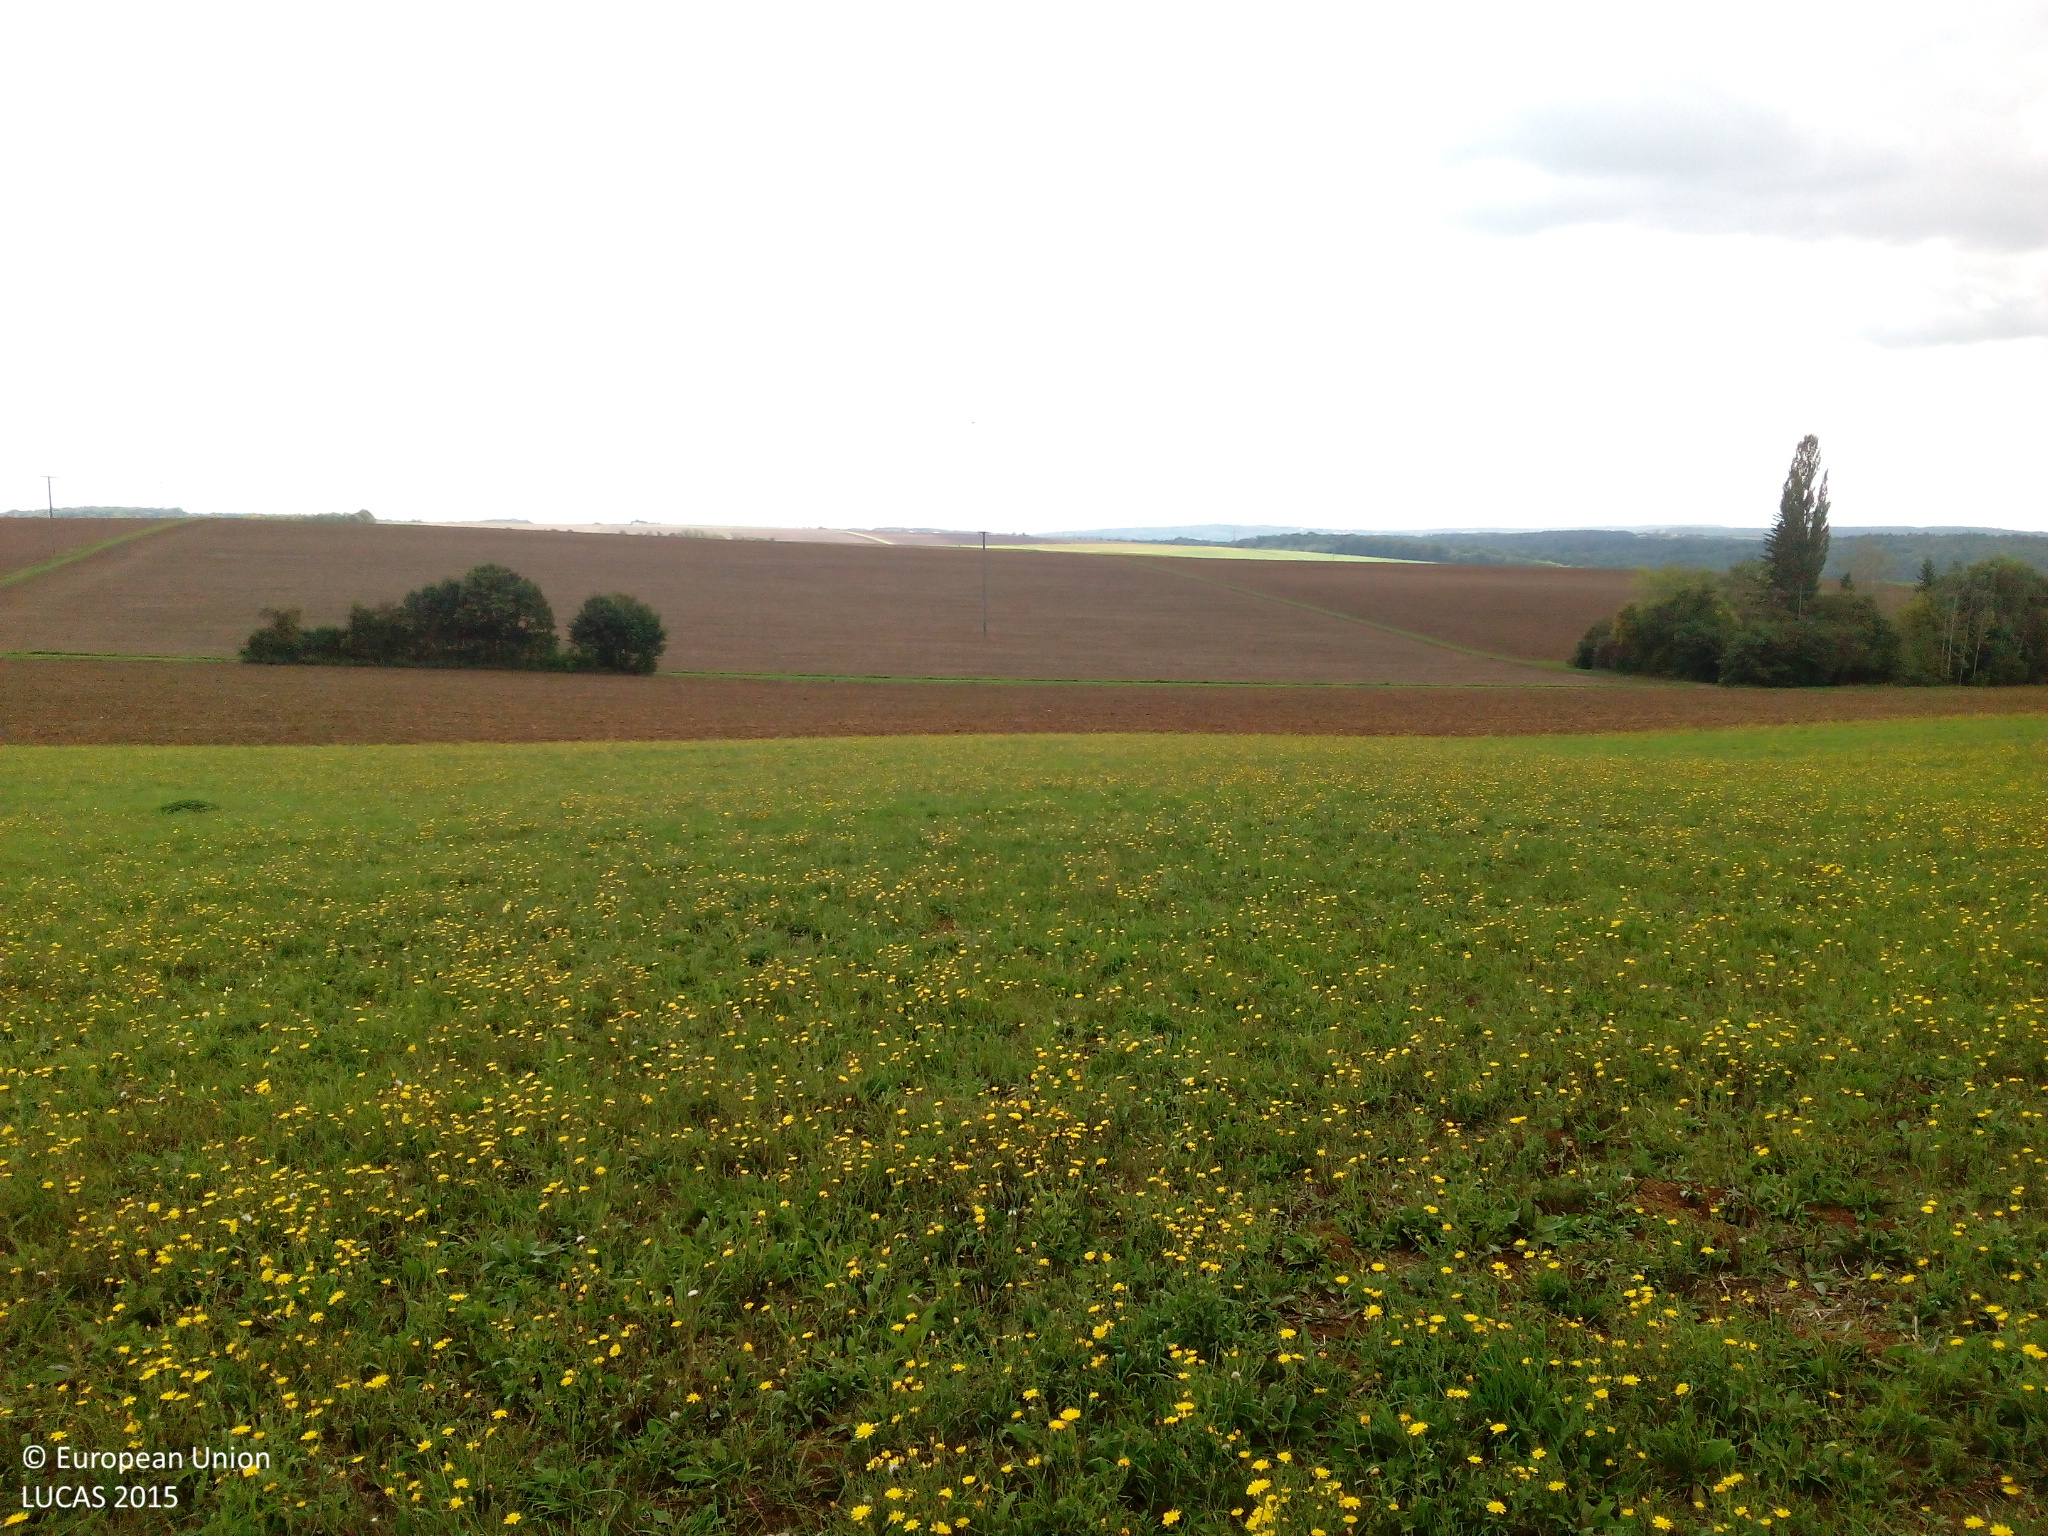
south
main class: Grassland
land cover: Grassland without tree/shrub cover
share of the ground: > 75 %
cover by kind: herbaceous plants 90 %, unconsolidated bare surface 10 %
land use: Agriculture (excluding fallow land and kitchen gardens)
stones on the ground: 10 - 25 %
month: September
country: DE
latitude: 49.8605
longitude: 9.9305
